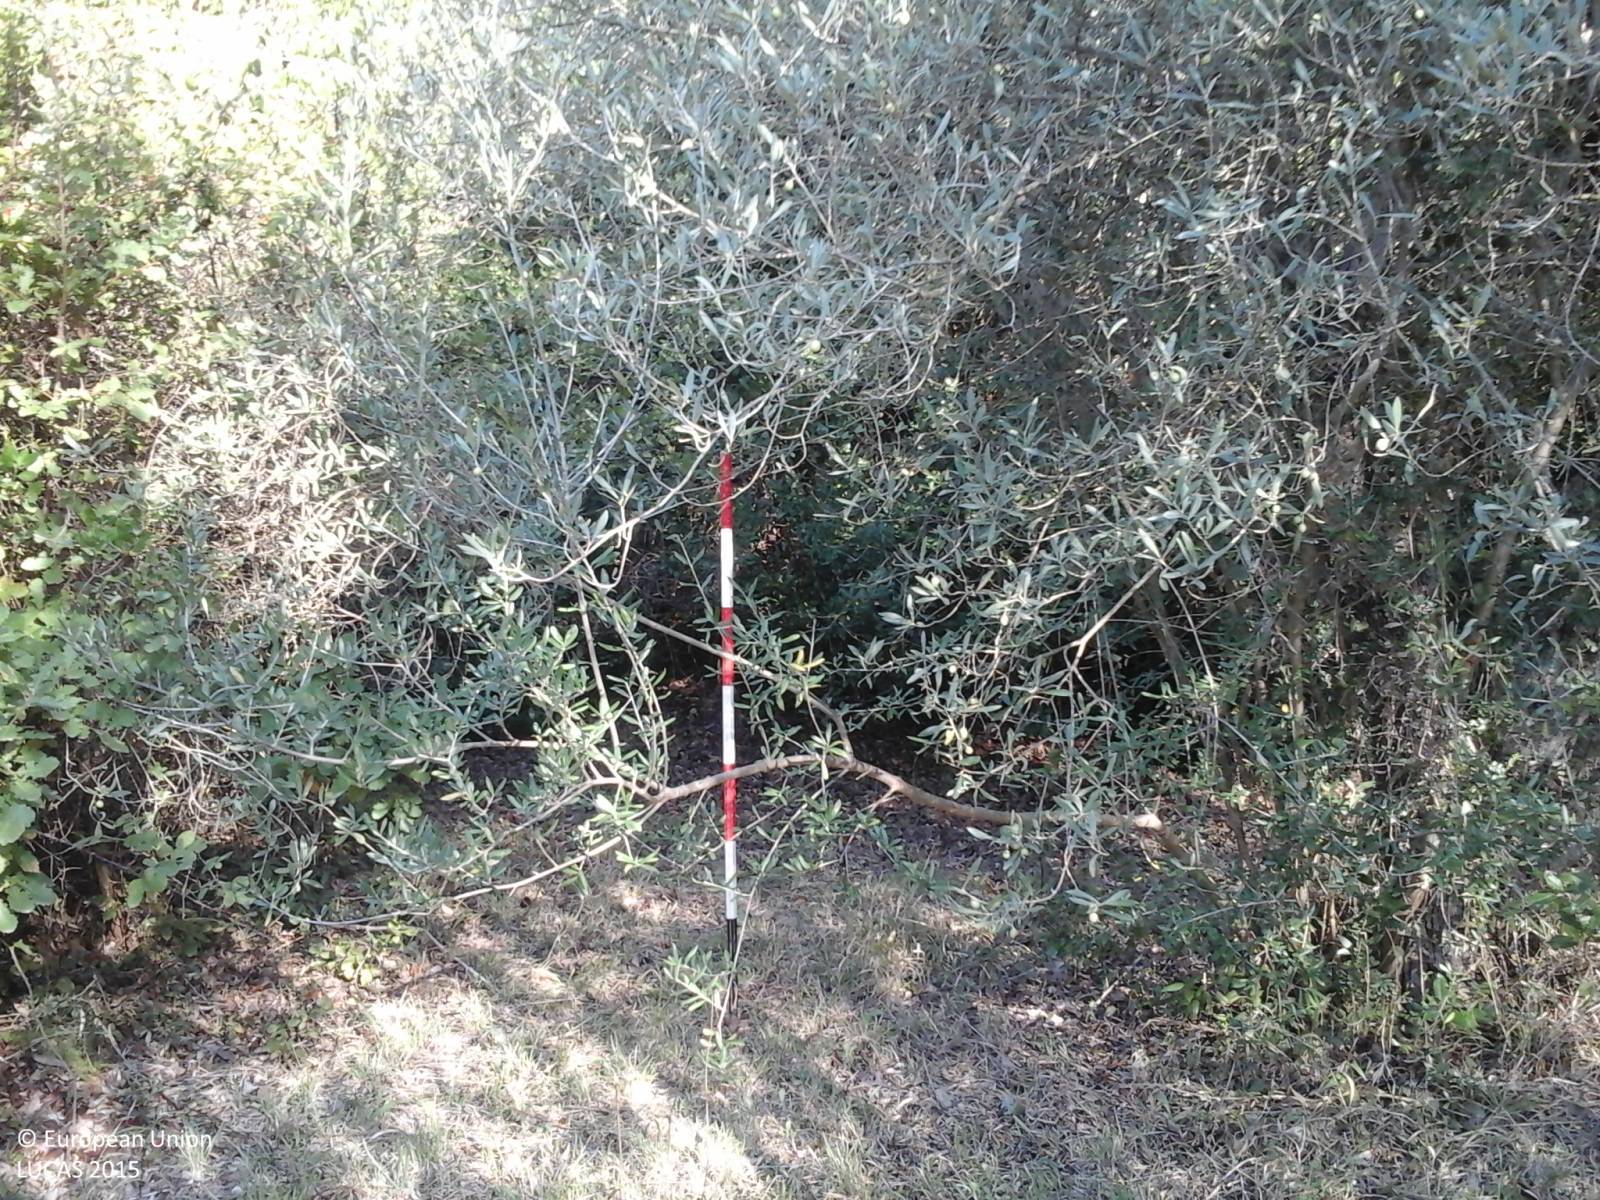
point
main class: Cropland
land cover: Olive groves
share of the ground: 25 - 50 %
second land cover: Grassland without tree/shrub cover
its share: 25 - 50 %
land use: Agriculture (excluding fallow land and kitchen gardens)
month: October
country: IT
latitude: 40.2557
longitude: 8.4912
